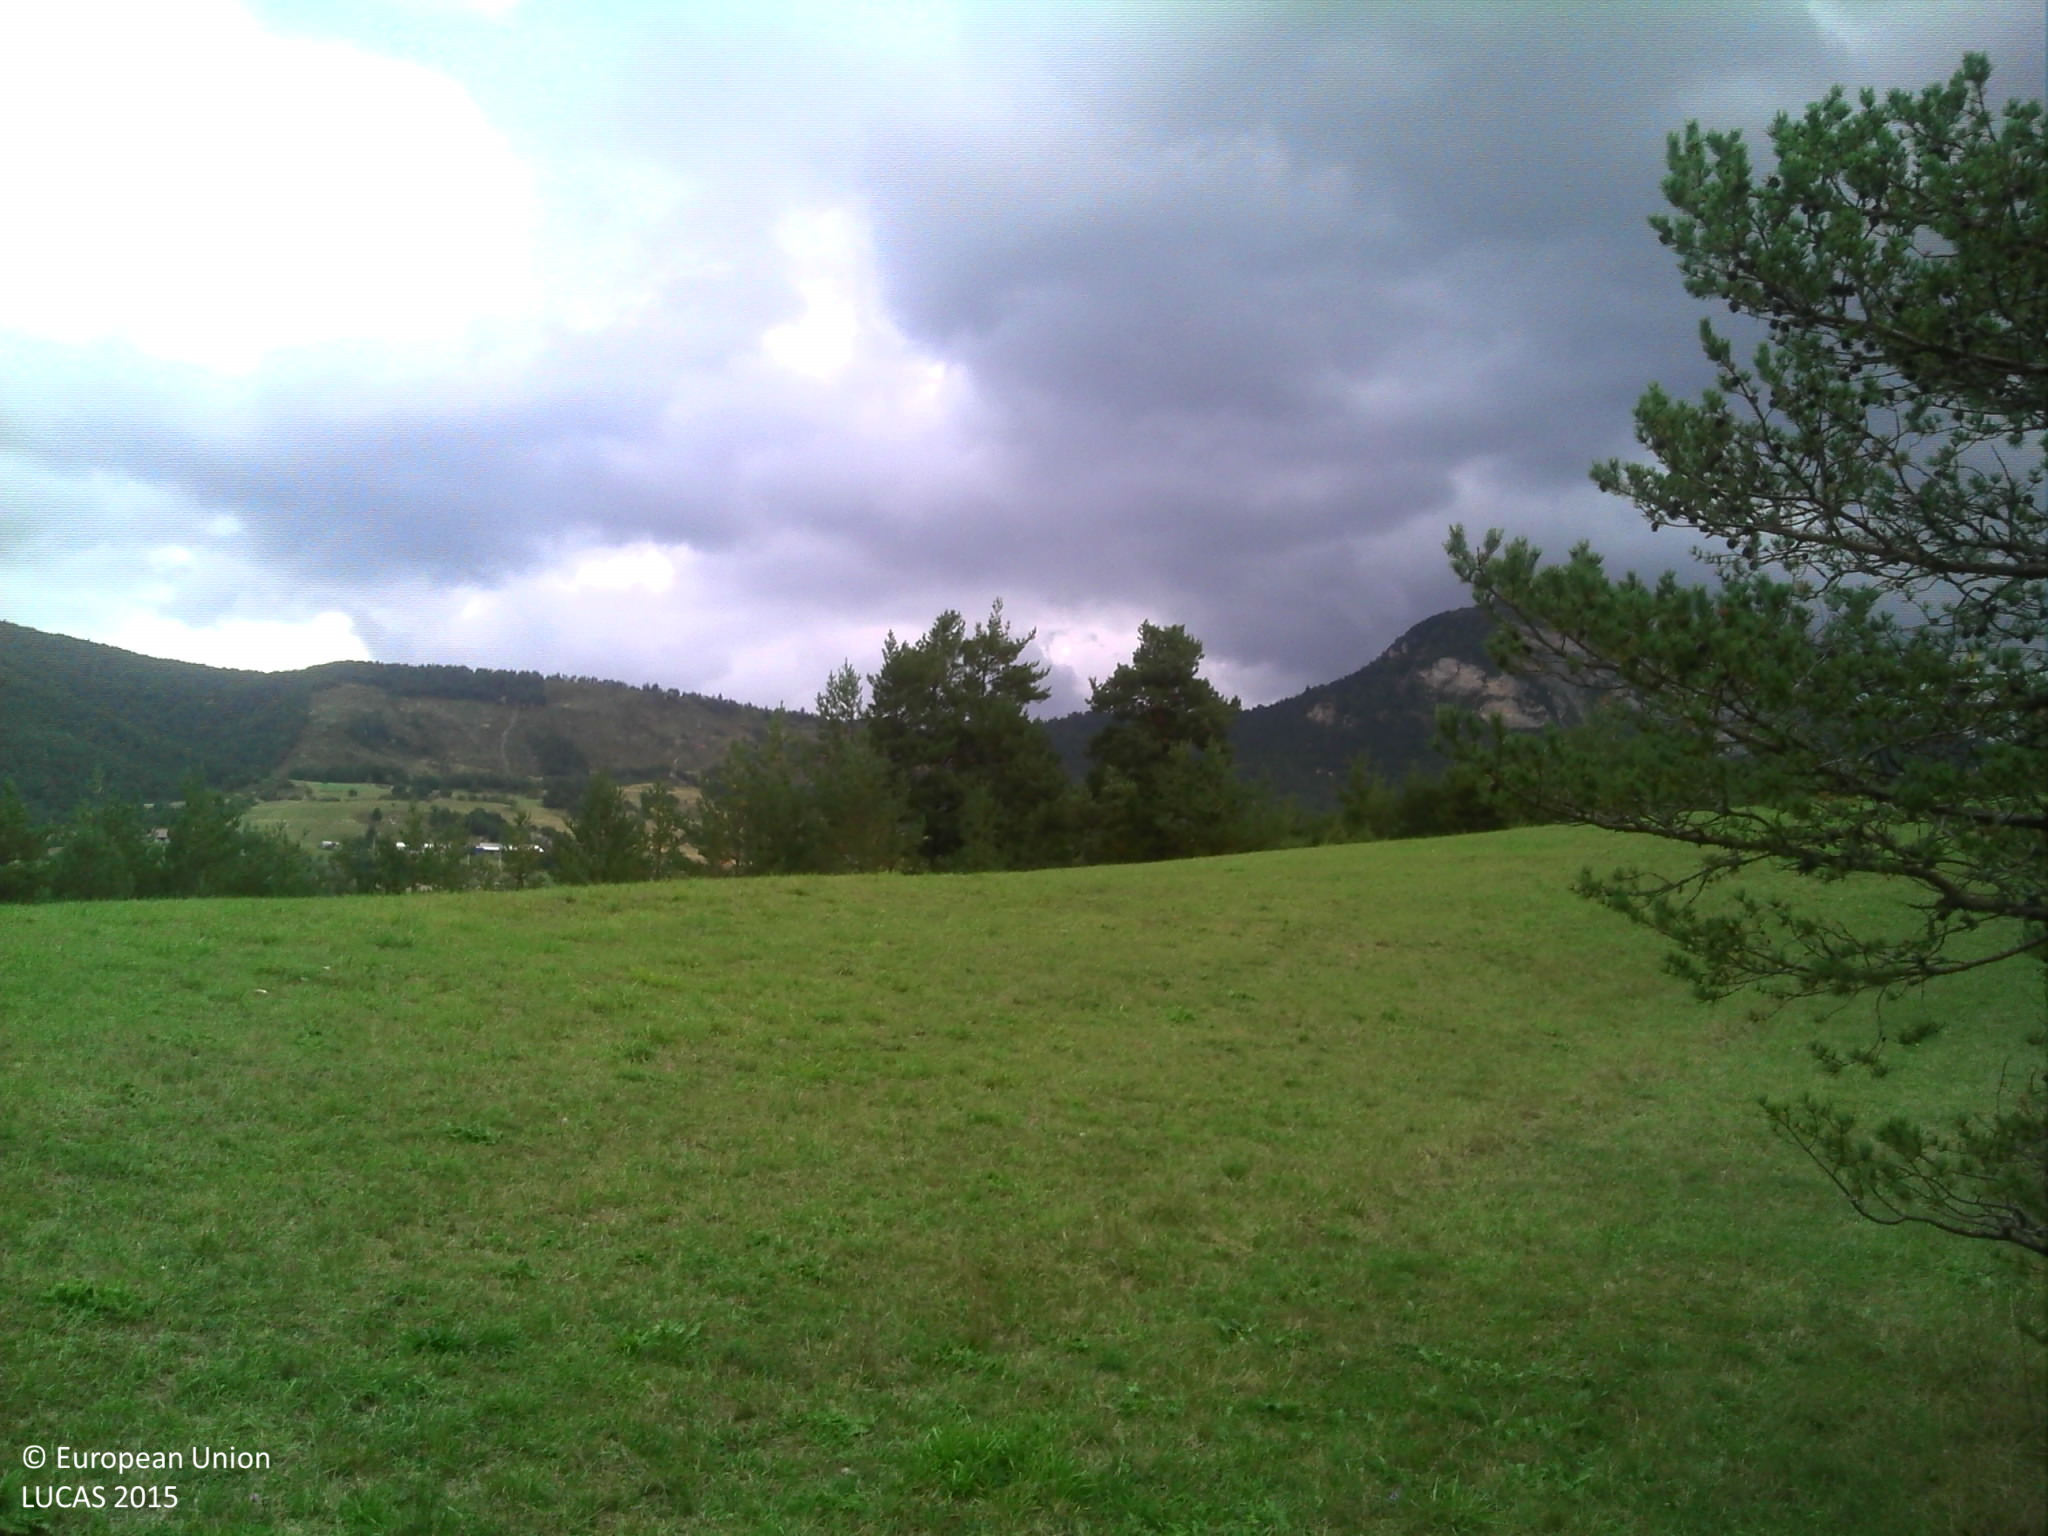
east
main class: Grassland
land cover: Grassland without tree/shrub cover
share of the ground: > 75 %
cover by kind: herbaceous plants 95 %, shrubs 5 %
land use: Agriculture (excluding fallow land and kitchen gardens)
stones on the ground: > 50 %
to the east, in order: Grassland without tree/shrub cover; Pine dominated coniferous woodland; Other bare soil; Grassland with sparse tree/shrub cover; Pine dominated coniferous woodland
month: September
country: FR
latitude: 44.5055
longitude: 5.4914
